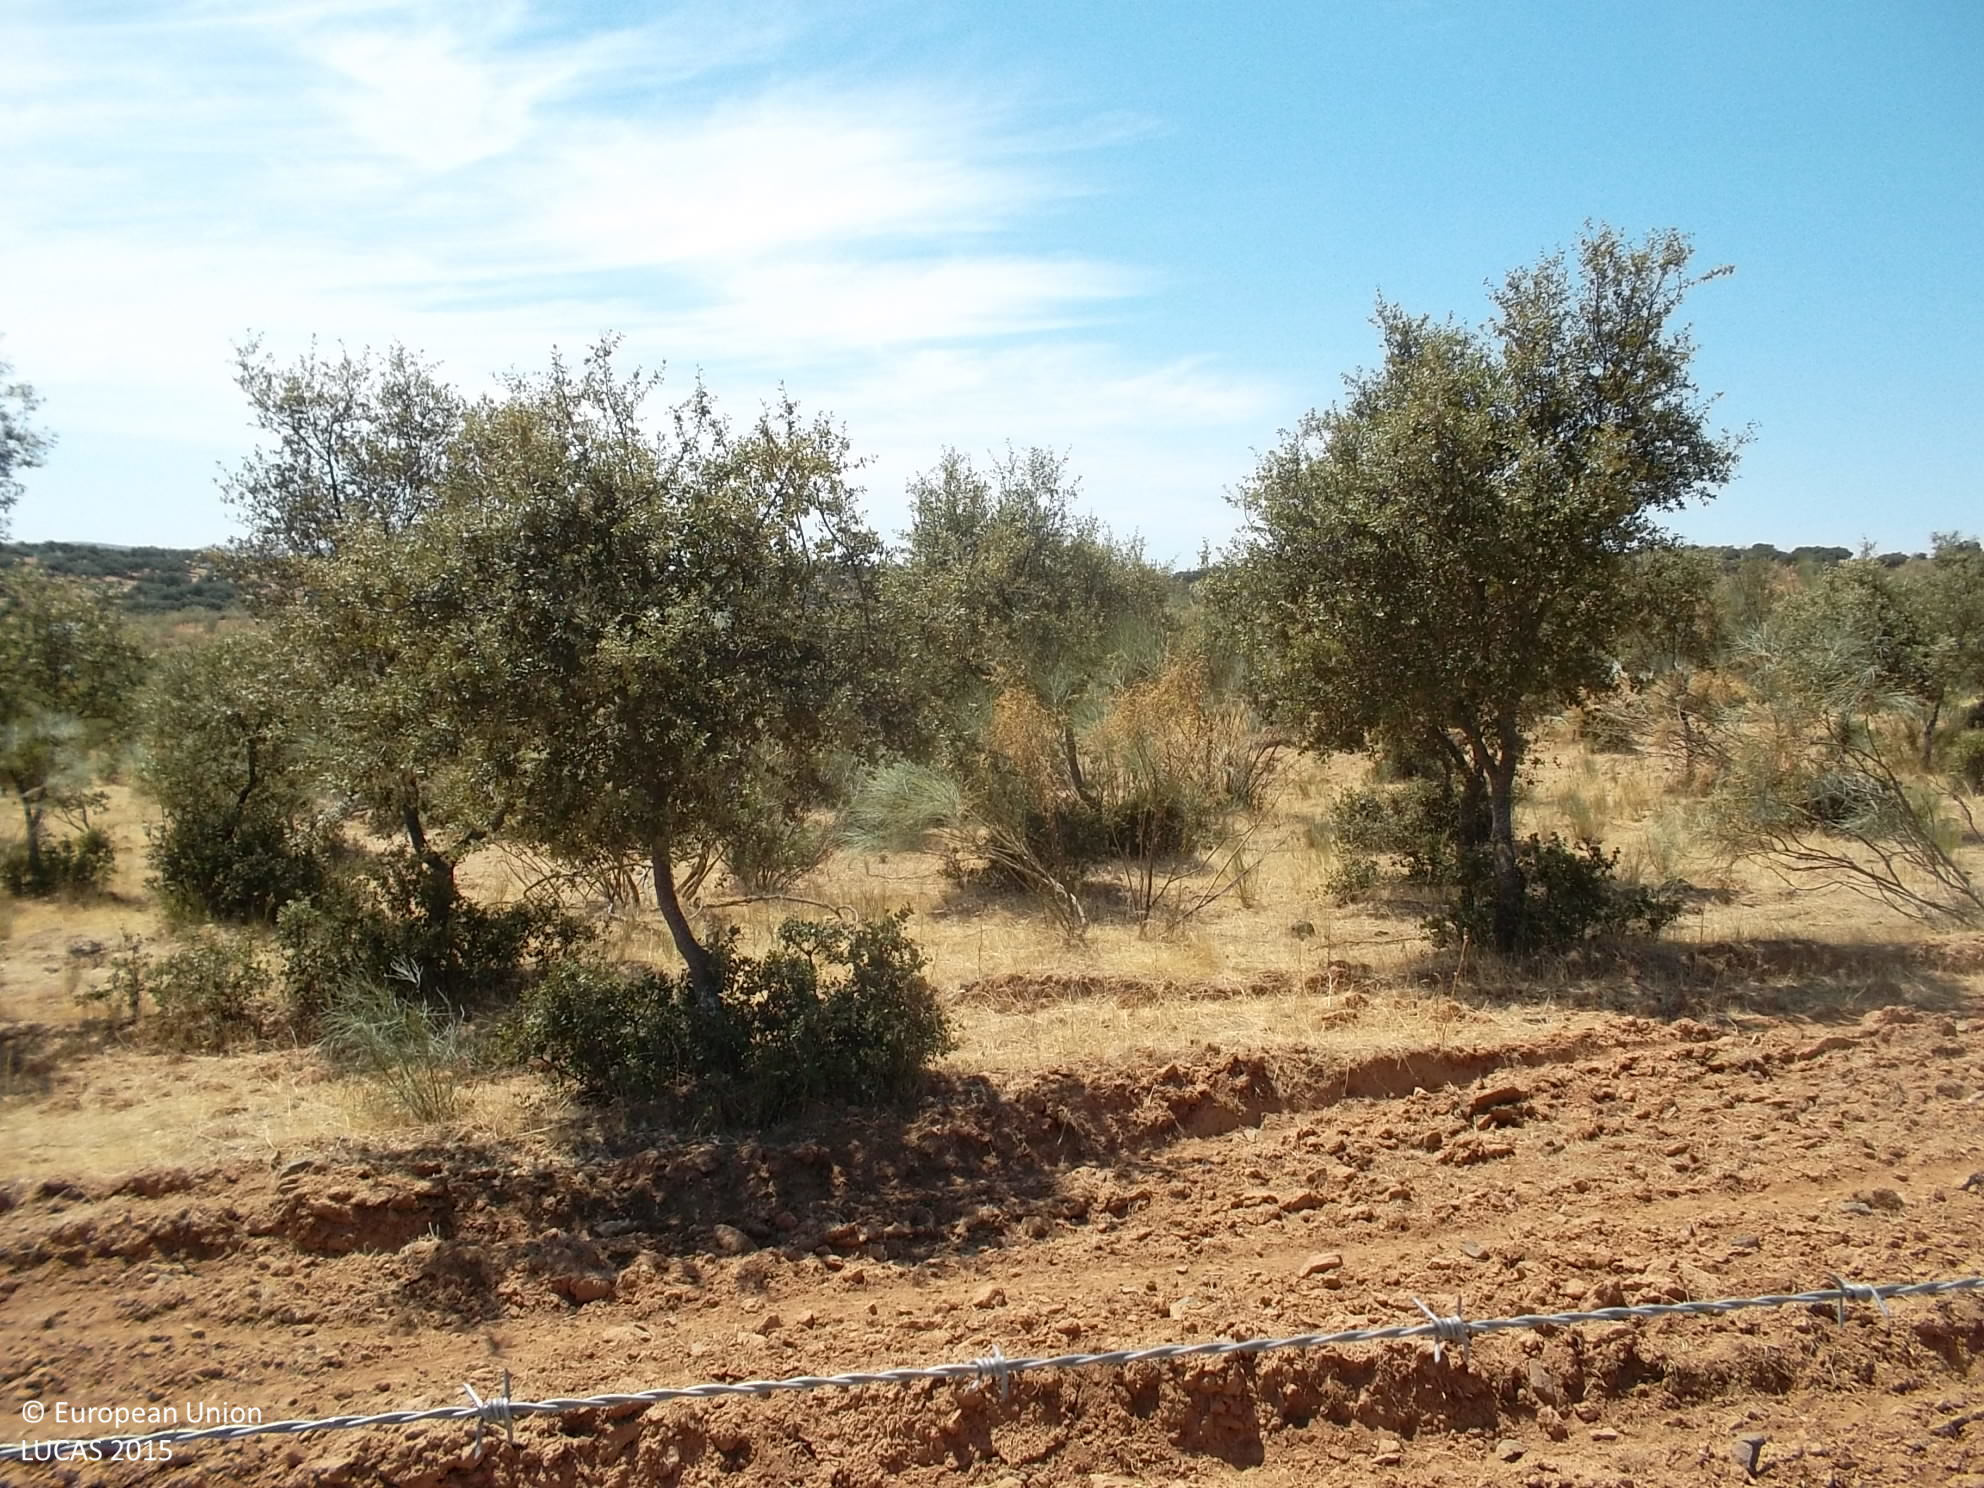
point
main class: Woodland
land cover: Broadleaved woodland
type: broadleaved evergreen forest
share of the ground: 25 - 50 %
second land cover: Grassland without tree/shrub cover
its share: > 75 %
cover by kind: herbaceous plants 70 %, broadleaved forest trees 30 %
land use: Forestry
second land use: Agriculture (excluding fallow land and kitchen gardens)
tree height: < 5 m
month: August
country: ES
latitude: 38.2368
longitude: -6.5819
